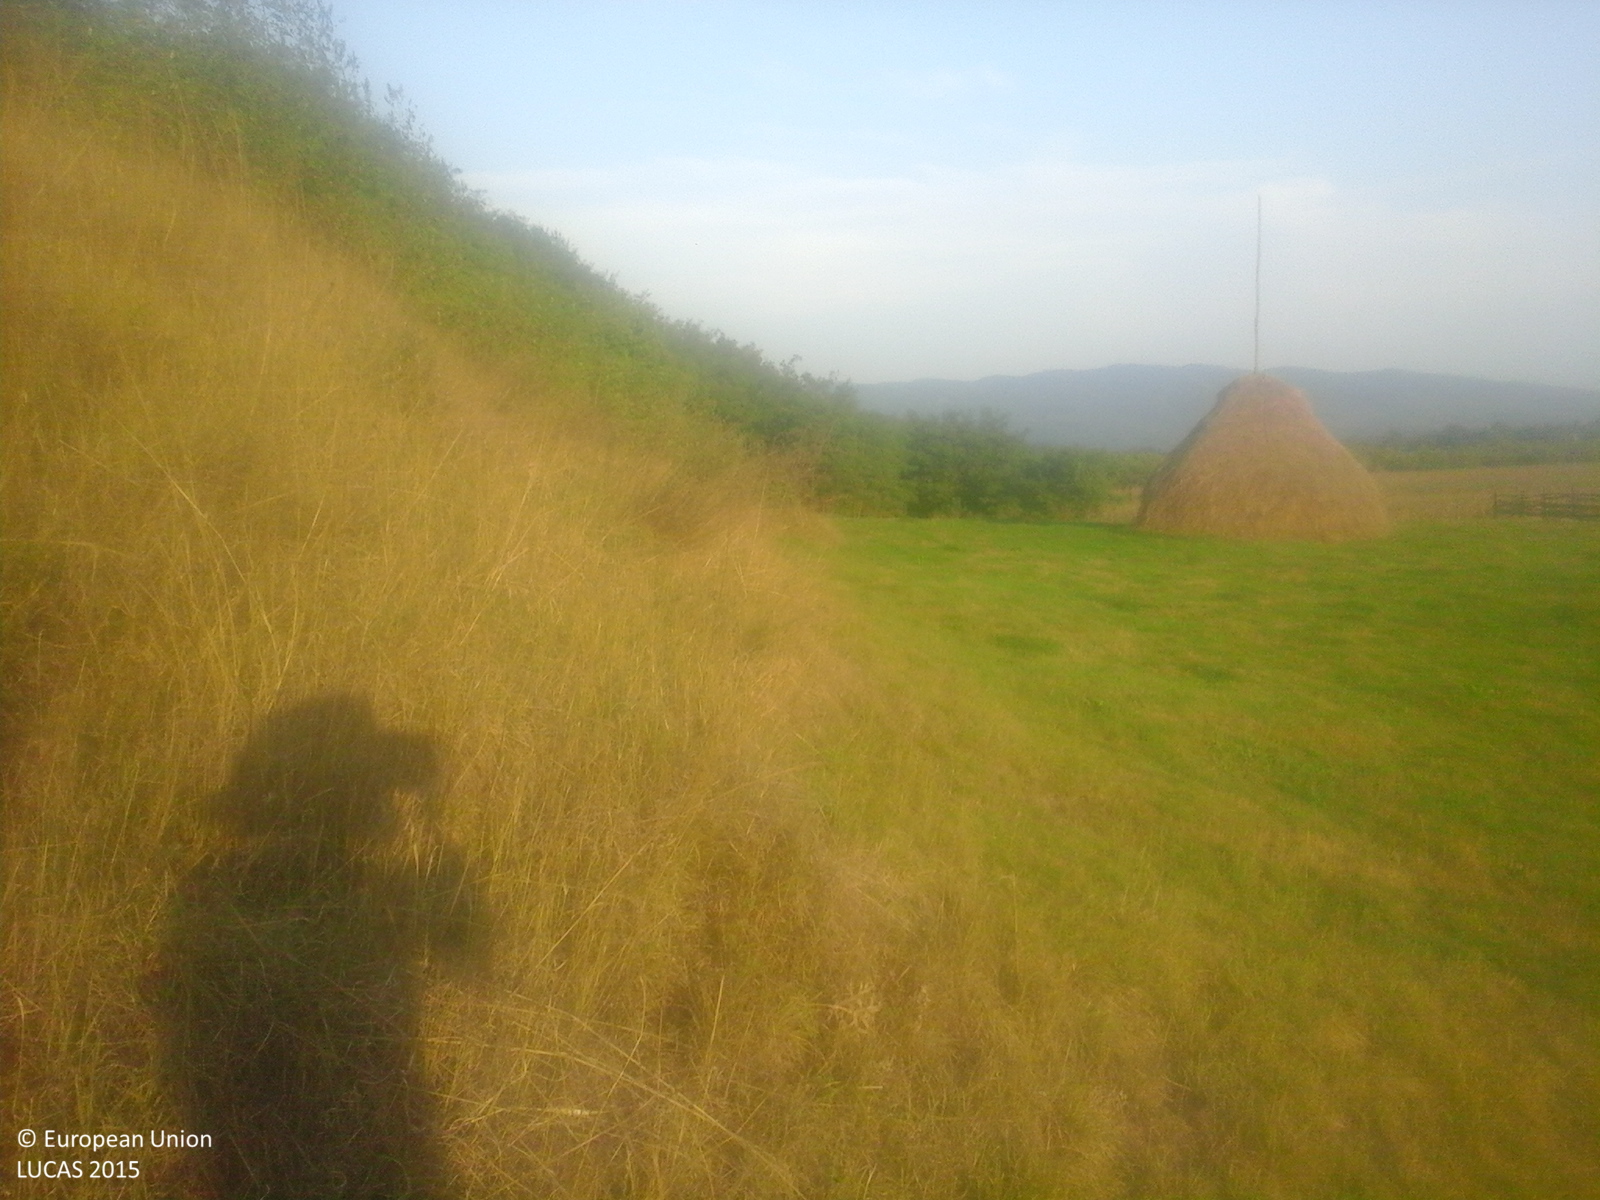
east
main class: Grassland
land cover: Grassland without tree/shrub cover
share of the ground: > 75 %
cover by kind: herbaceous plants 100 %
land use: Agriculture (excluding fallow land and kitchen gardens)
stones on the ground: < 10 %
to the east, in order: Grassland without tree/shrub cover; Broadleaved woodland
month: September
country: RO
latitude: 45.5263
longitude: 23.0755
